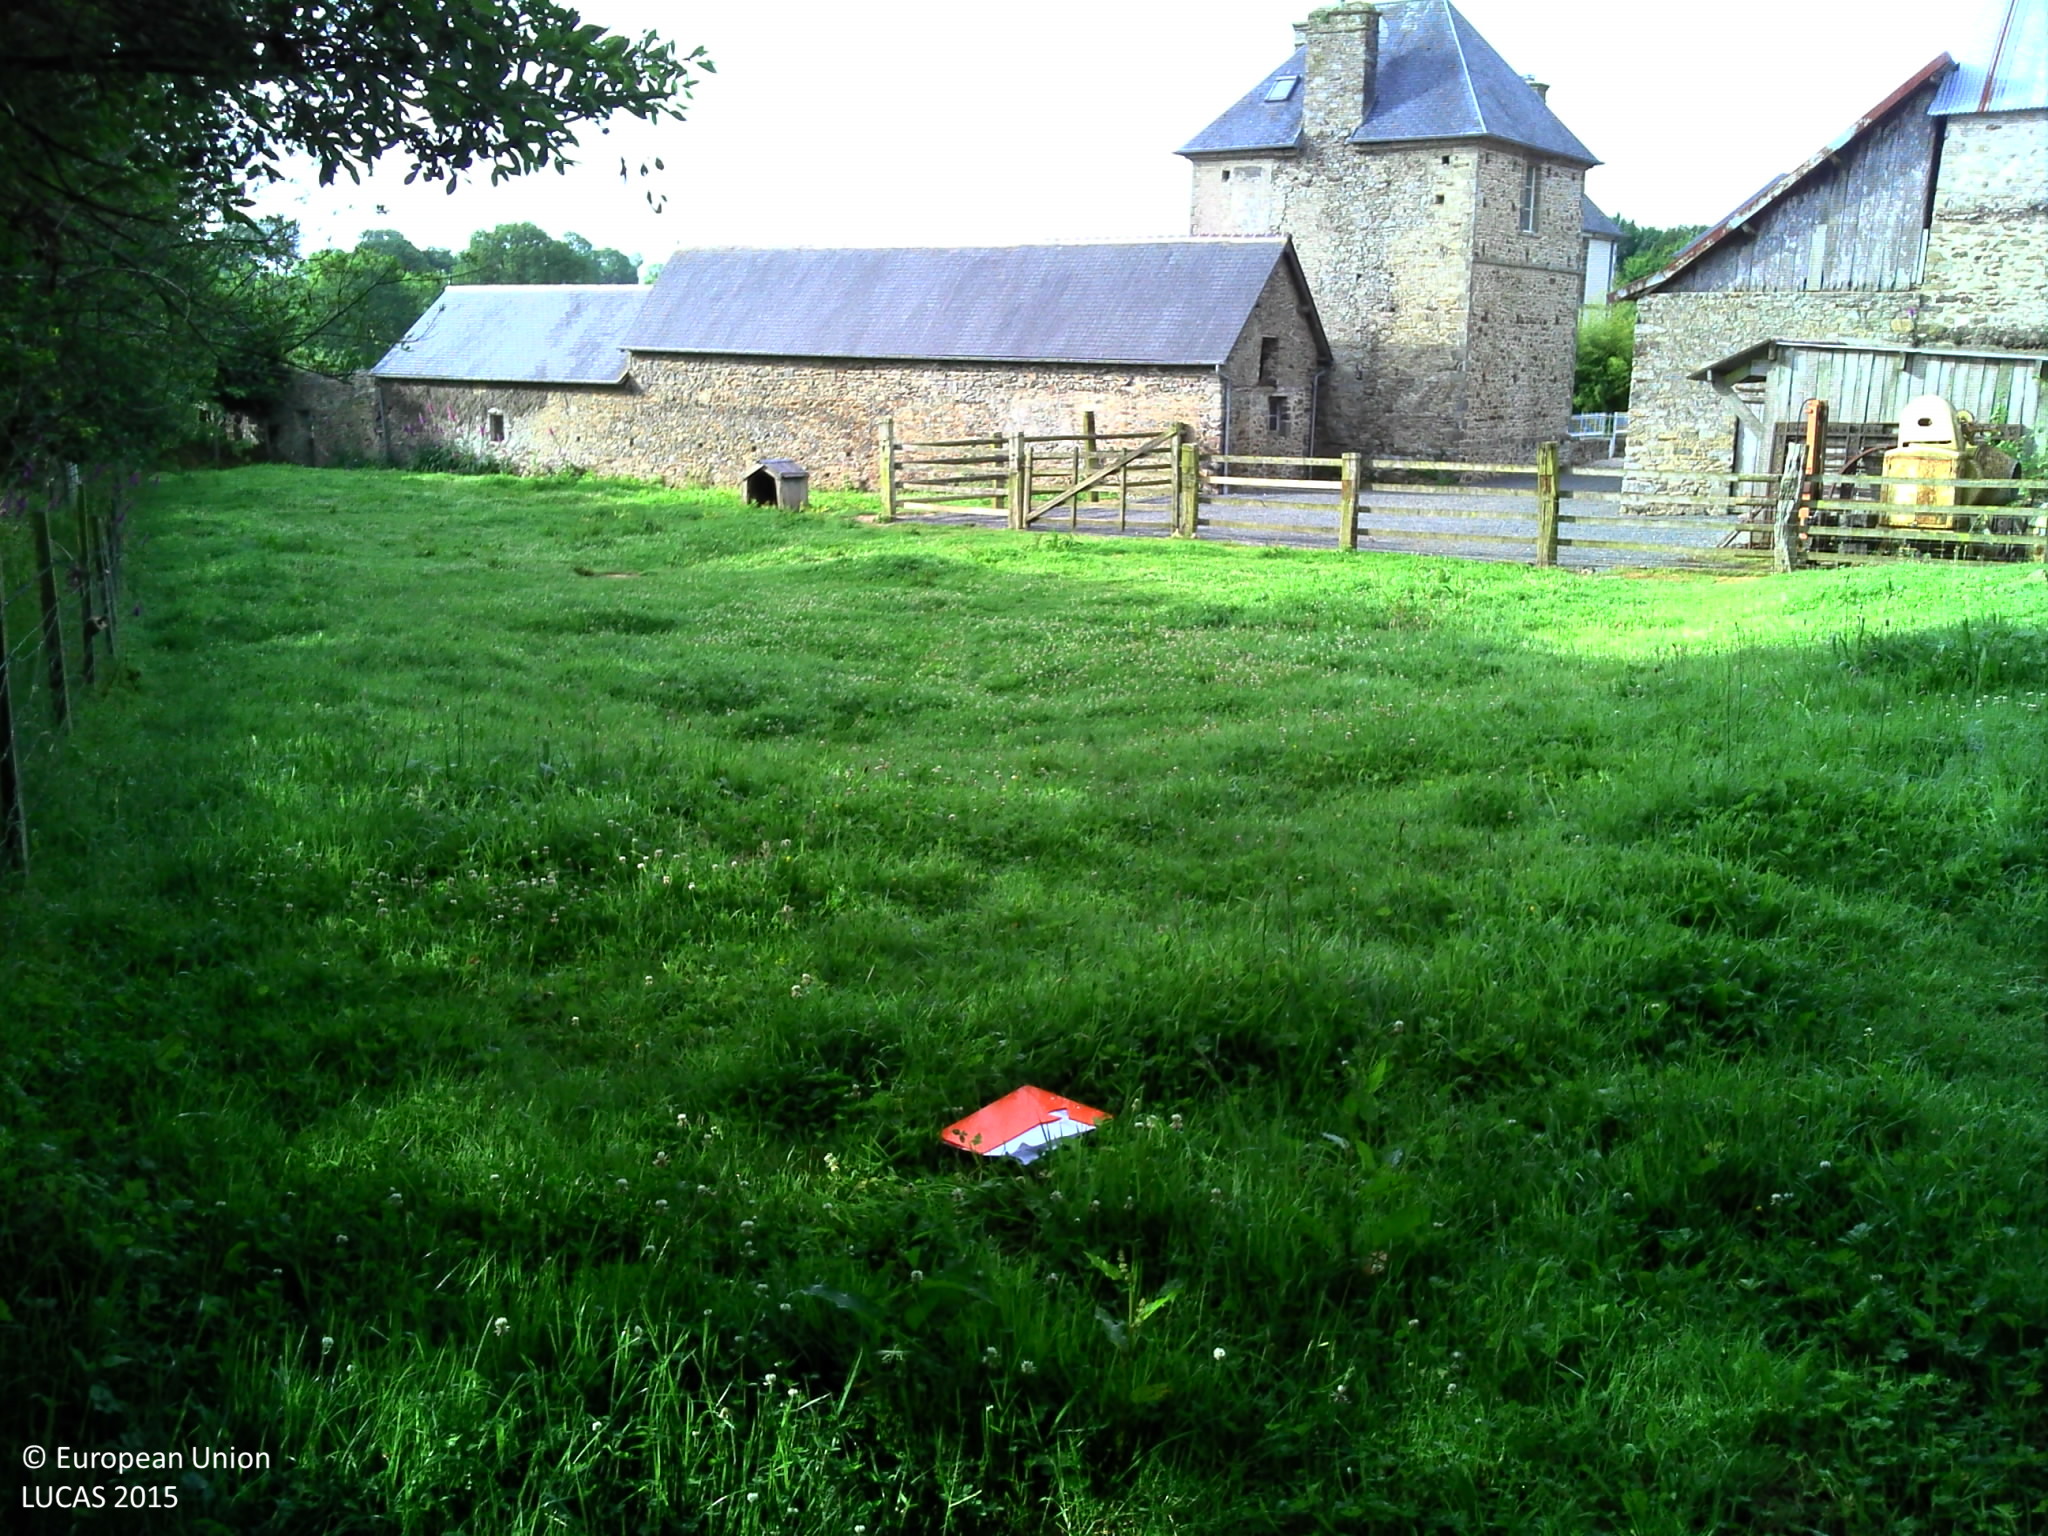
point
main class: Grassland
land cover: Grassland without tree/shrub cover
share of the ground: > 75 %
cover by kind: herbaceous plants 100 %
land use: Agriculture (excluding fallow land and kitchen gardens)
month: June
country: FR
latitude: 49.0782
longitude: -1.4520
